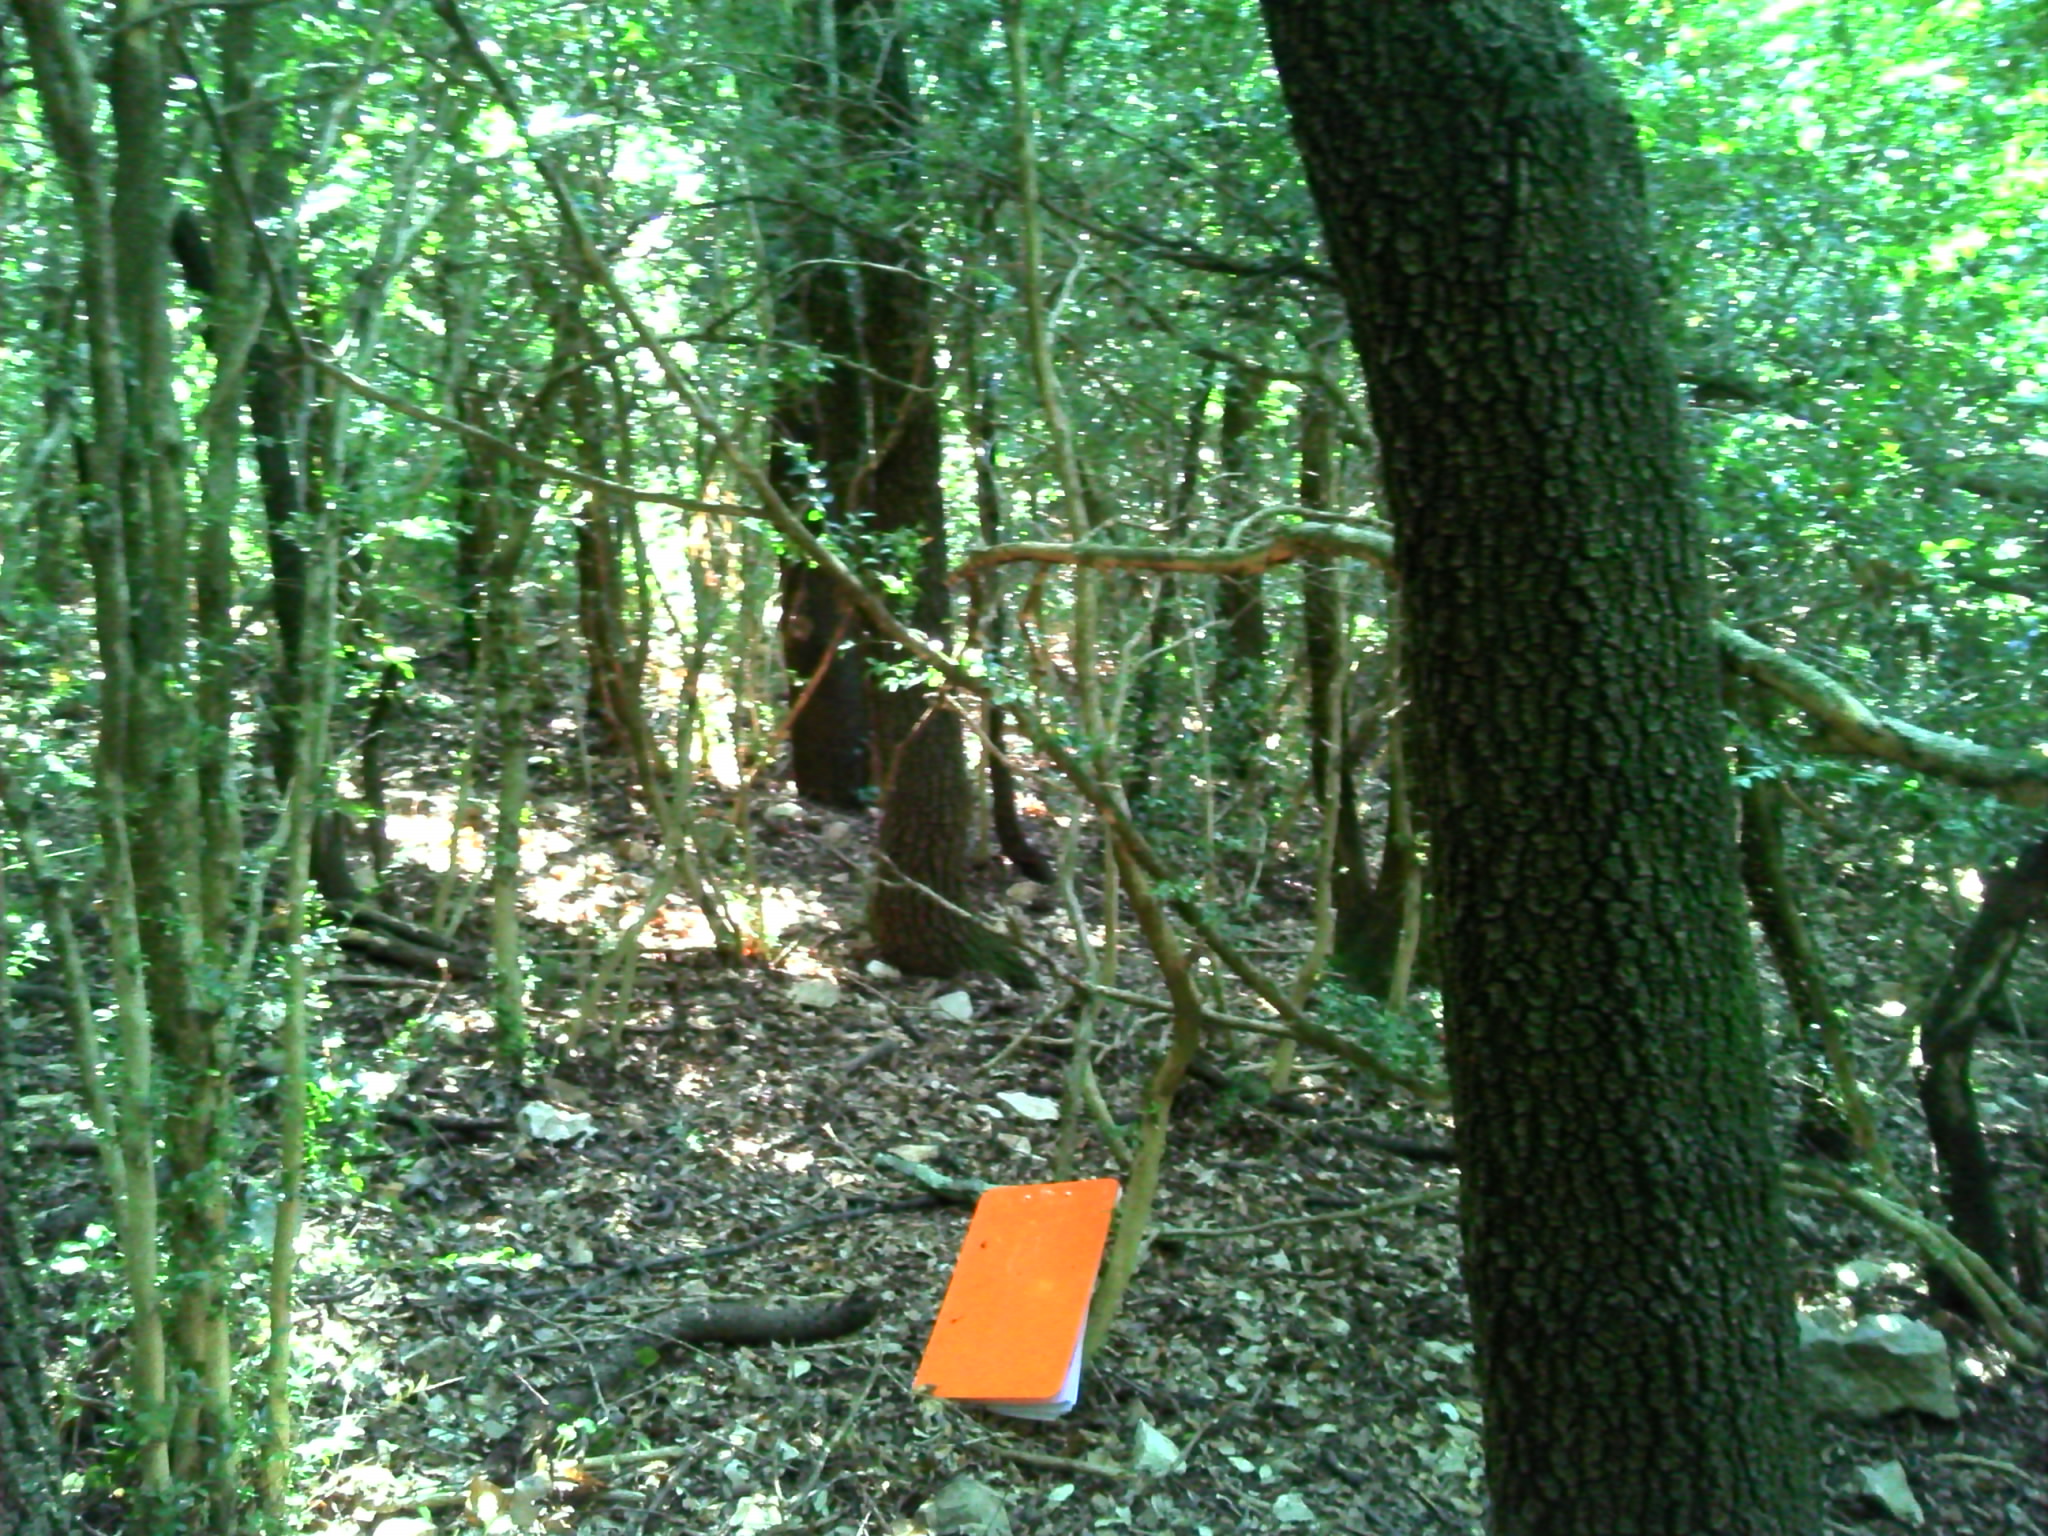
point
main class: Woodland
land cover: Broadleaved woodland
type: broadleaved evergreen forest
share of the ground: > 75 %
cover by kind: broadleaved forest trees 80 %, consolidated bare surface 15 %, herbaceous plants 5 %
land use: Forestry
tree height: > 5 m
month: August
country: FR
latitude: 43.9961
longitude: 4.6587
